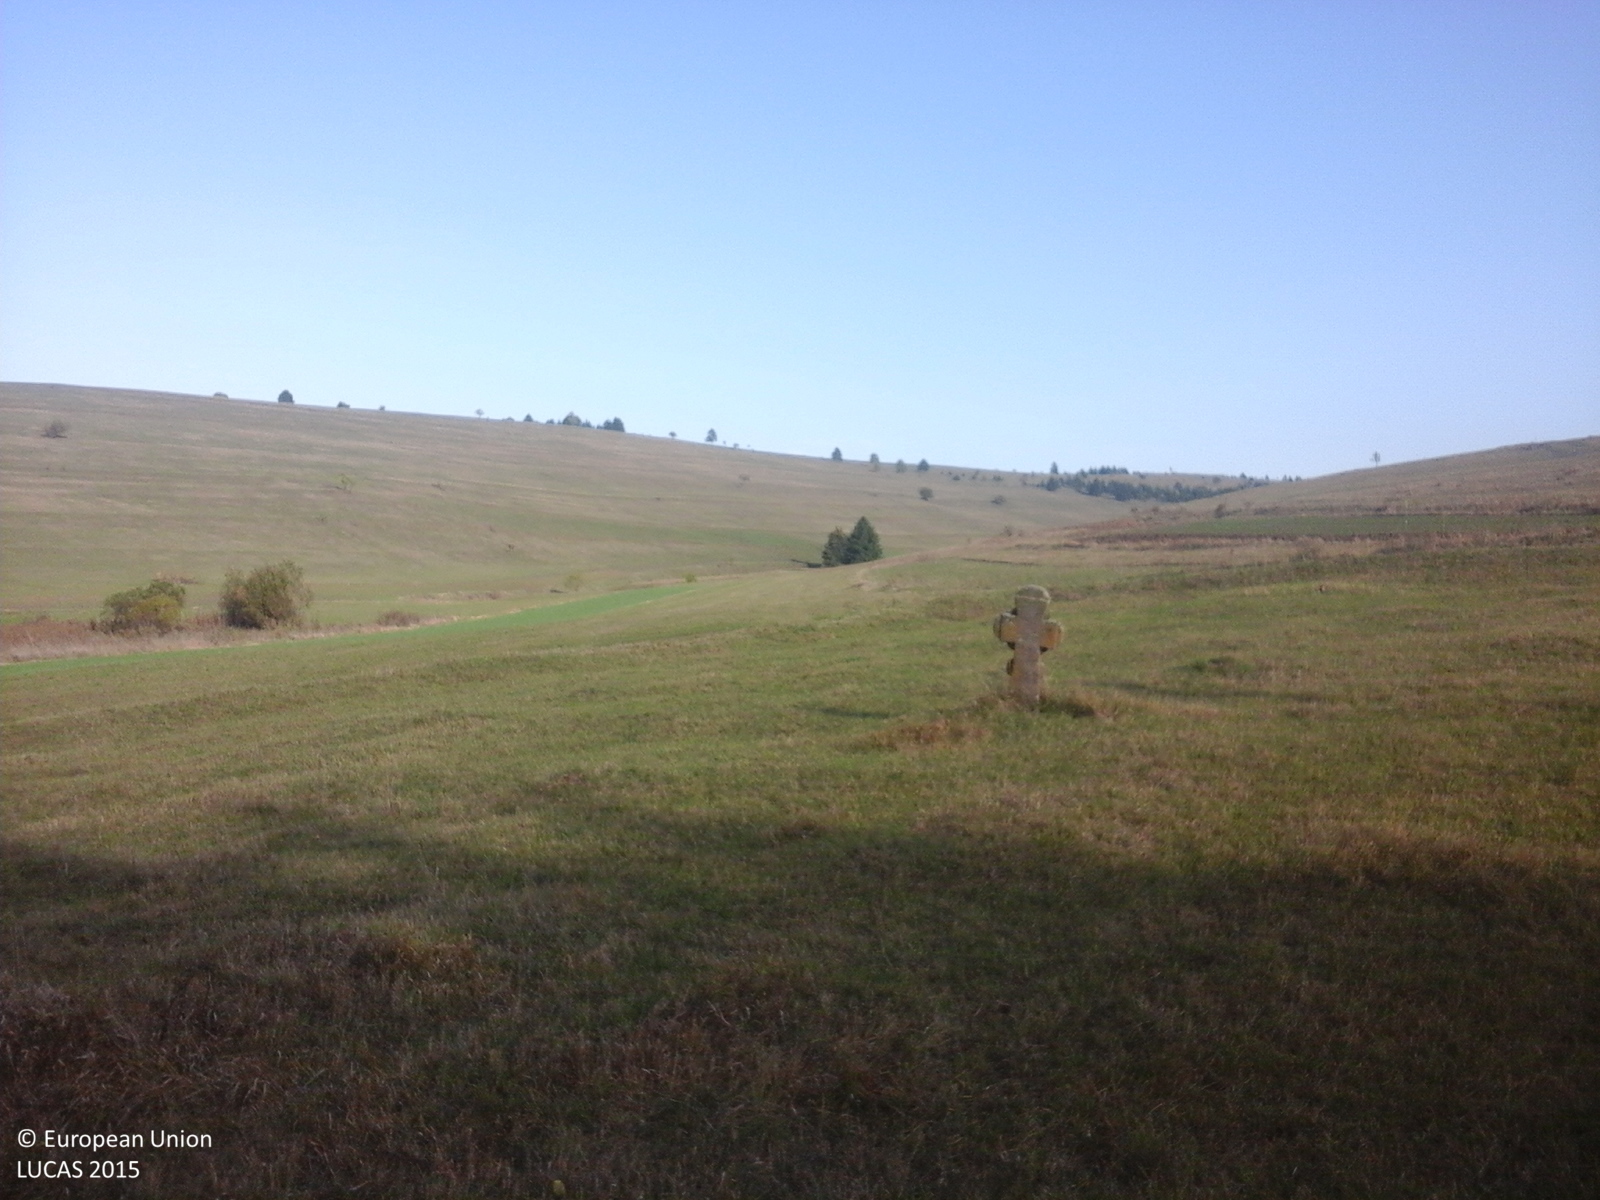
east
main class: Grassland
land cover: Grassland without tree/shrub cover
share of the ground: > 75 %
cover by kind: herbaceous plants 100 %
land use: Agriculture (excluding fallow land and kitchen gardens)
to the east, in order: Grassland without tree/shrub cover; Tracks; Grassland without tree/shrub cover; Tracks; Grassland without tree/shrub cover
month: October
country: RO
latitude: 46.3516
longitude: 25.8531
